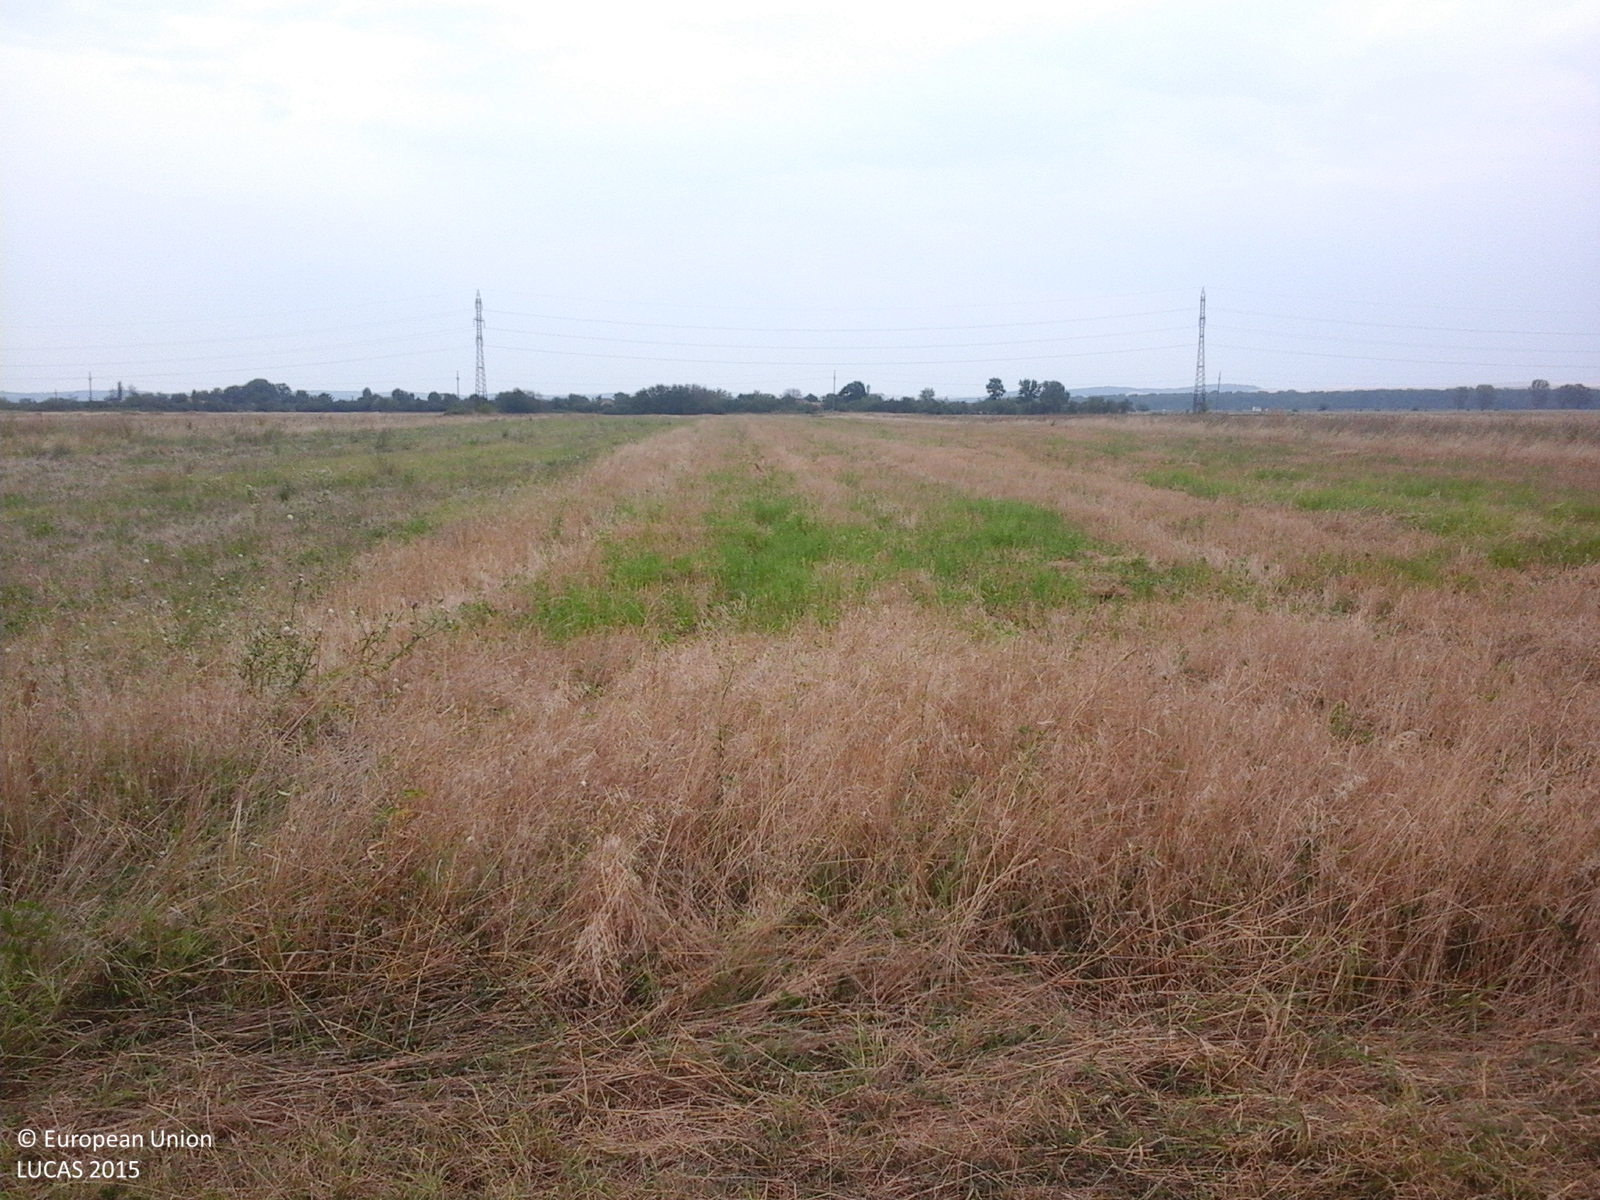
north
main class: Cropland
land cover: Sunflower
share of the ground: > 75 %
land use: Agriculture (excluding fallow land and kitchen gardens)
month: August
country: RO
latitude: 44.4099
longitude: 22.8132
